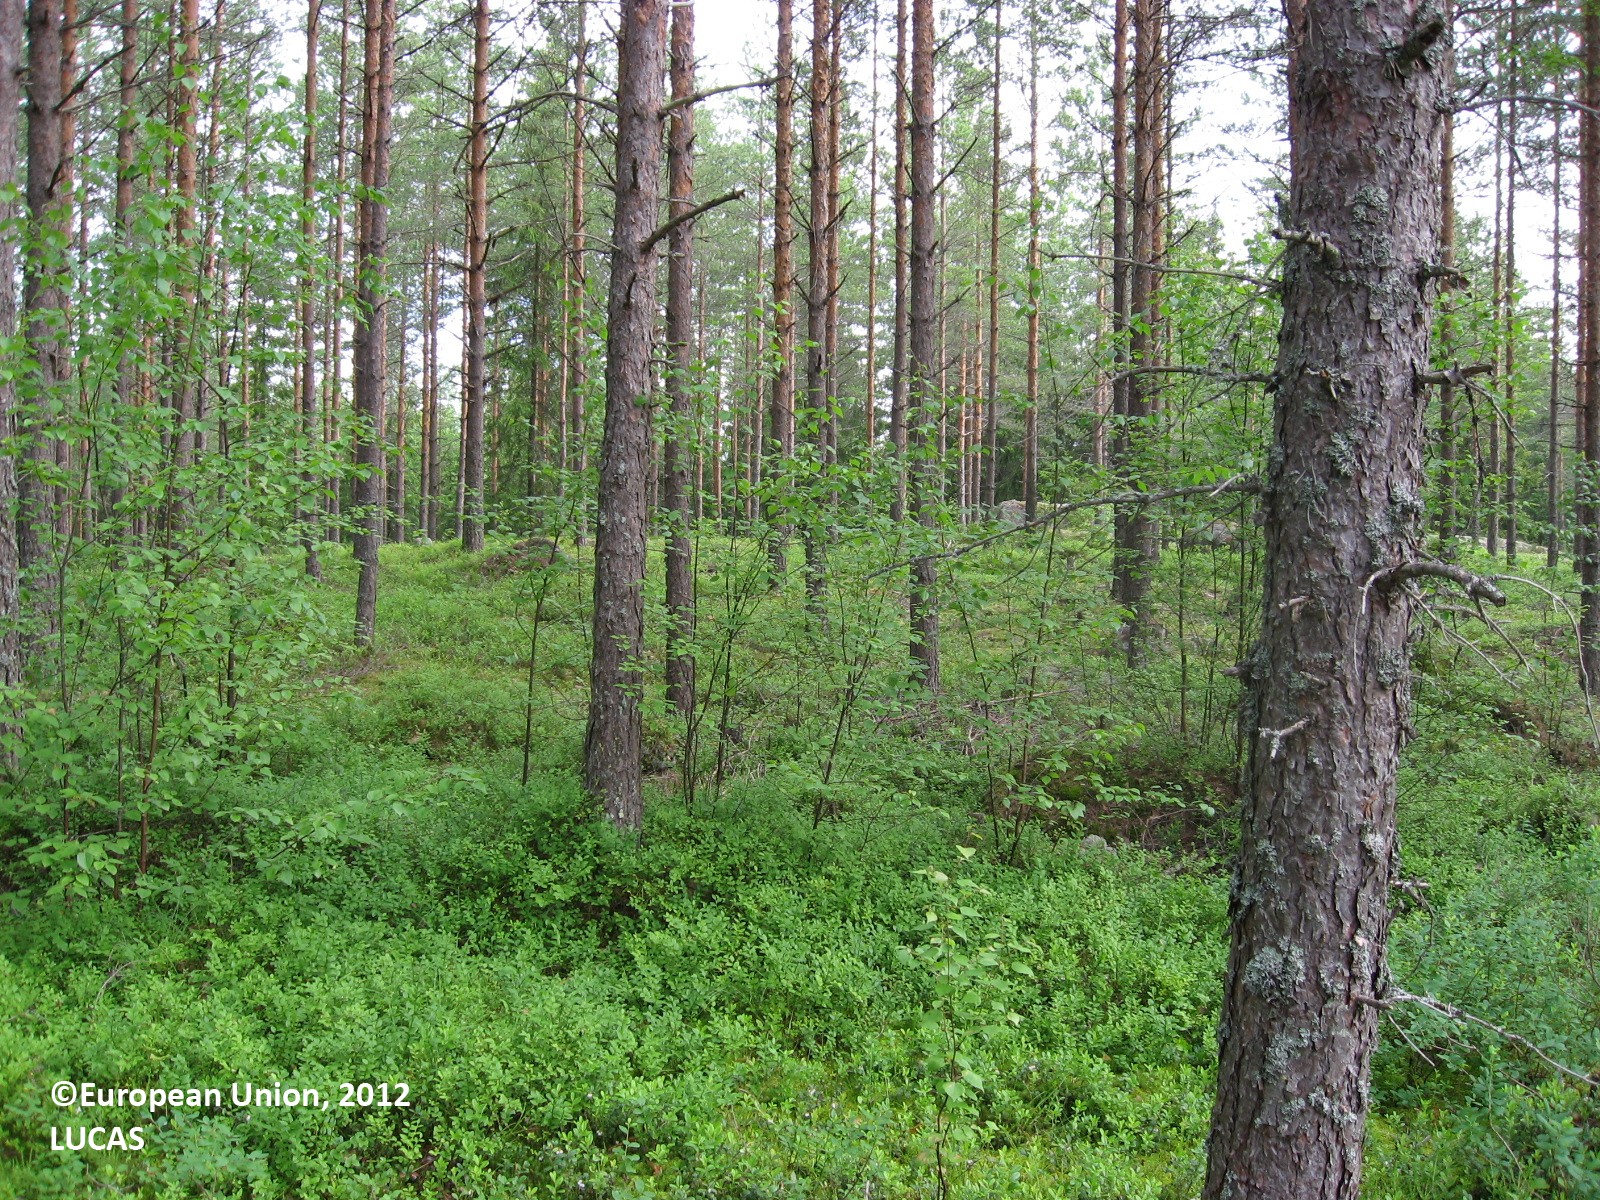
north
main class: Woodland
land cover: Pine dominated coniferous woodland
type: boreal forest
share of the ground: 50 - 75 %
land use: Forestry
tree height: > 5 m
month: June
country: FI
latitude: 60.6559
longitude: 26.1894
